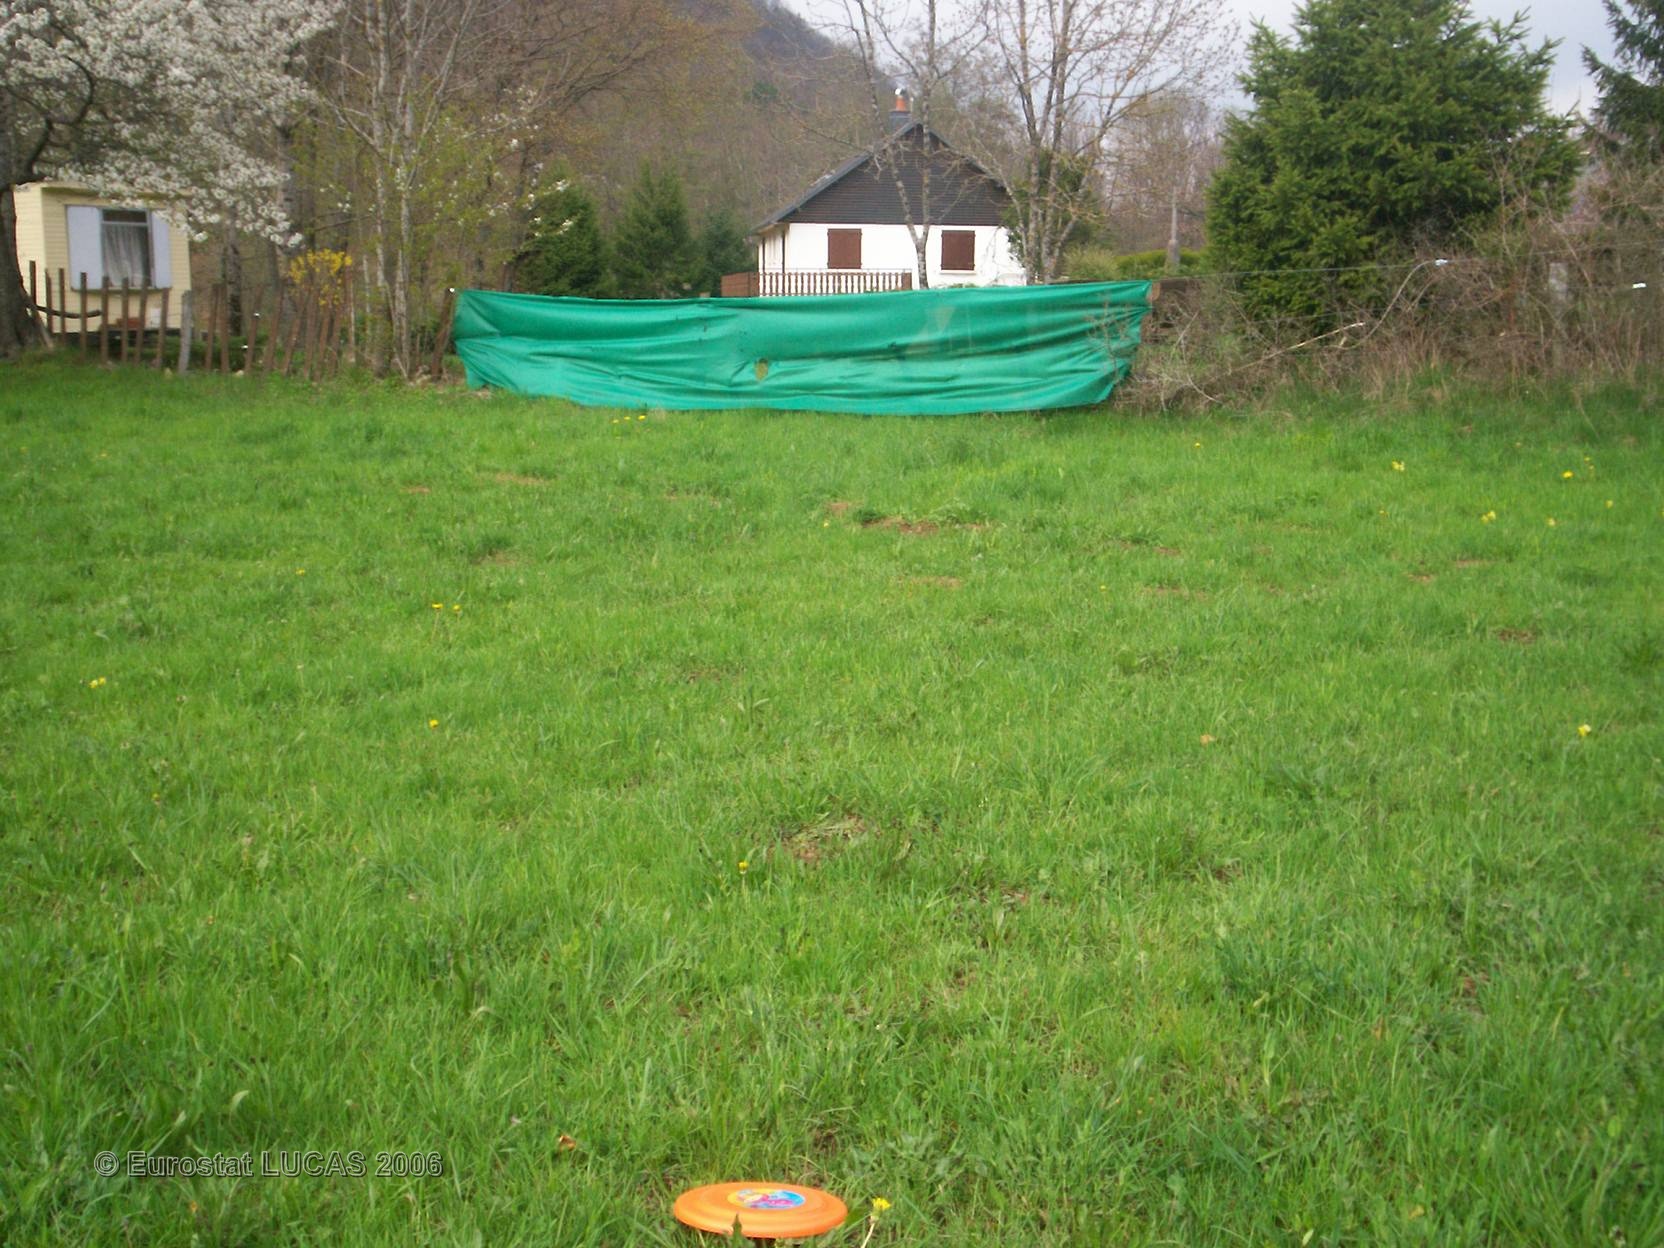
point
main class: Grassland
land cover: Grassland without tree/shrub cover
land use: Agriculture (excluding fallow land and kitchen gardens)
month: April
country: FR
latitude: 45.5232
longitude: 2.9714
